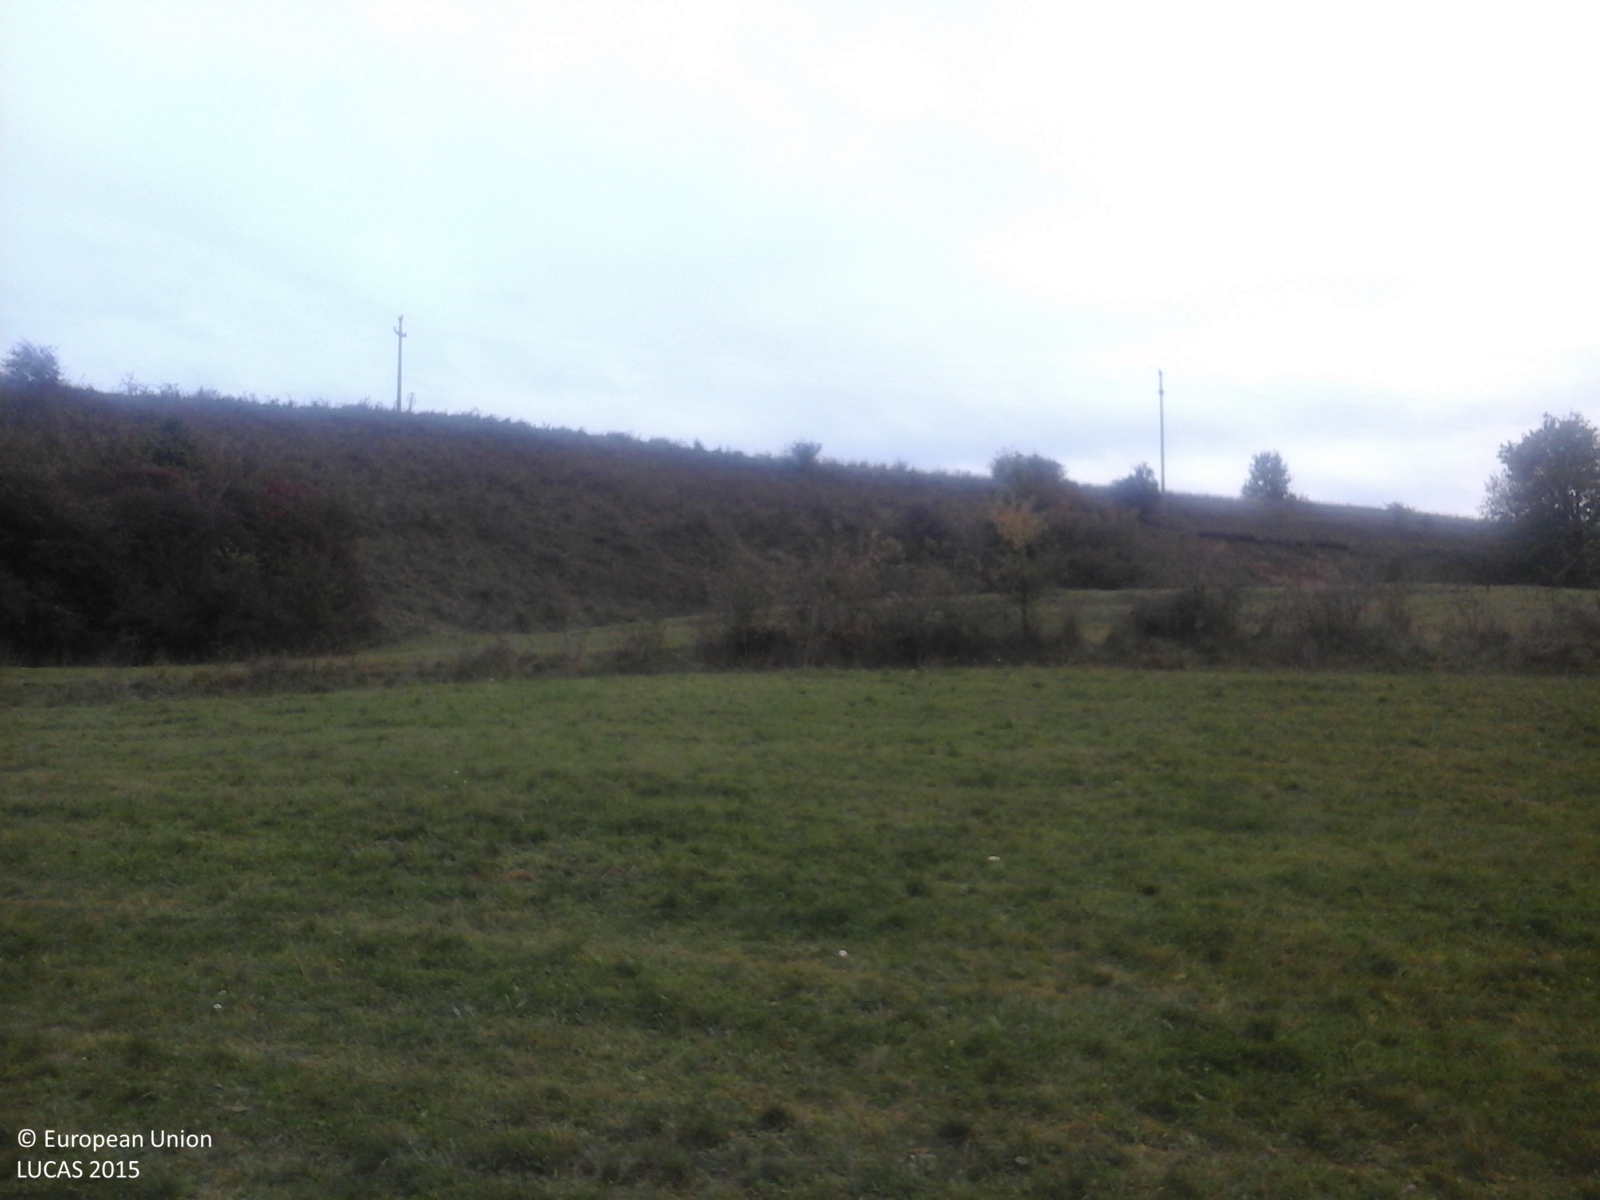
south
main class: Grassland
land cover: Grassland without tree/shrub cover
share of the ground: > 75 %
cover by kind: herbaceous plants 100 %
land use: Agriculture (excluding fallow land and kitchen gardens)
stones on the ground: < 10 %
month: October
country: RO
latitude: 46.2687
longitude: 25.2965
